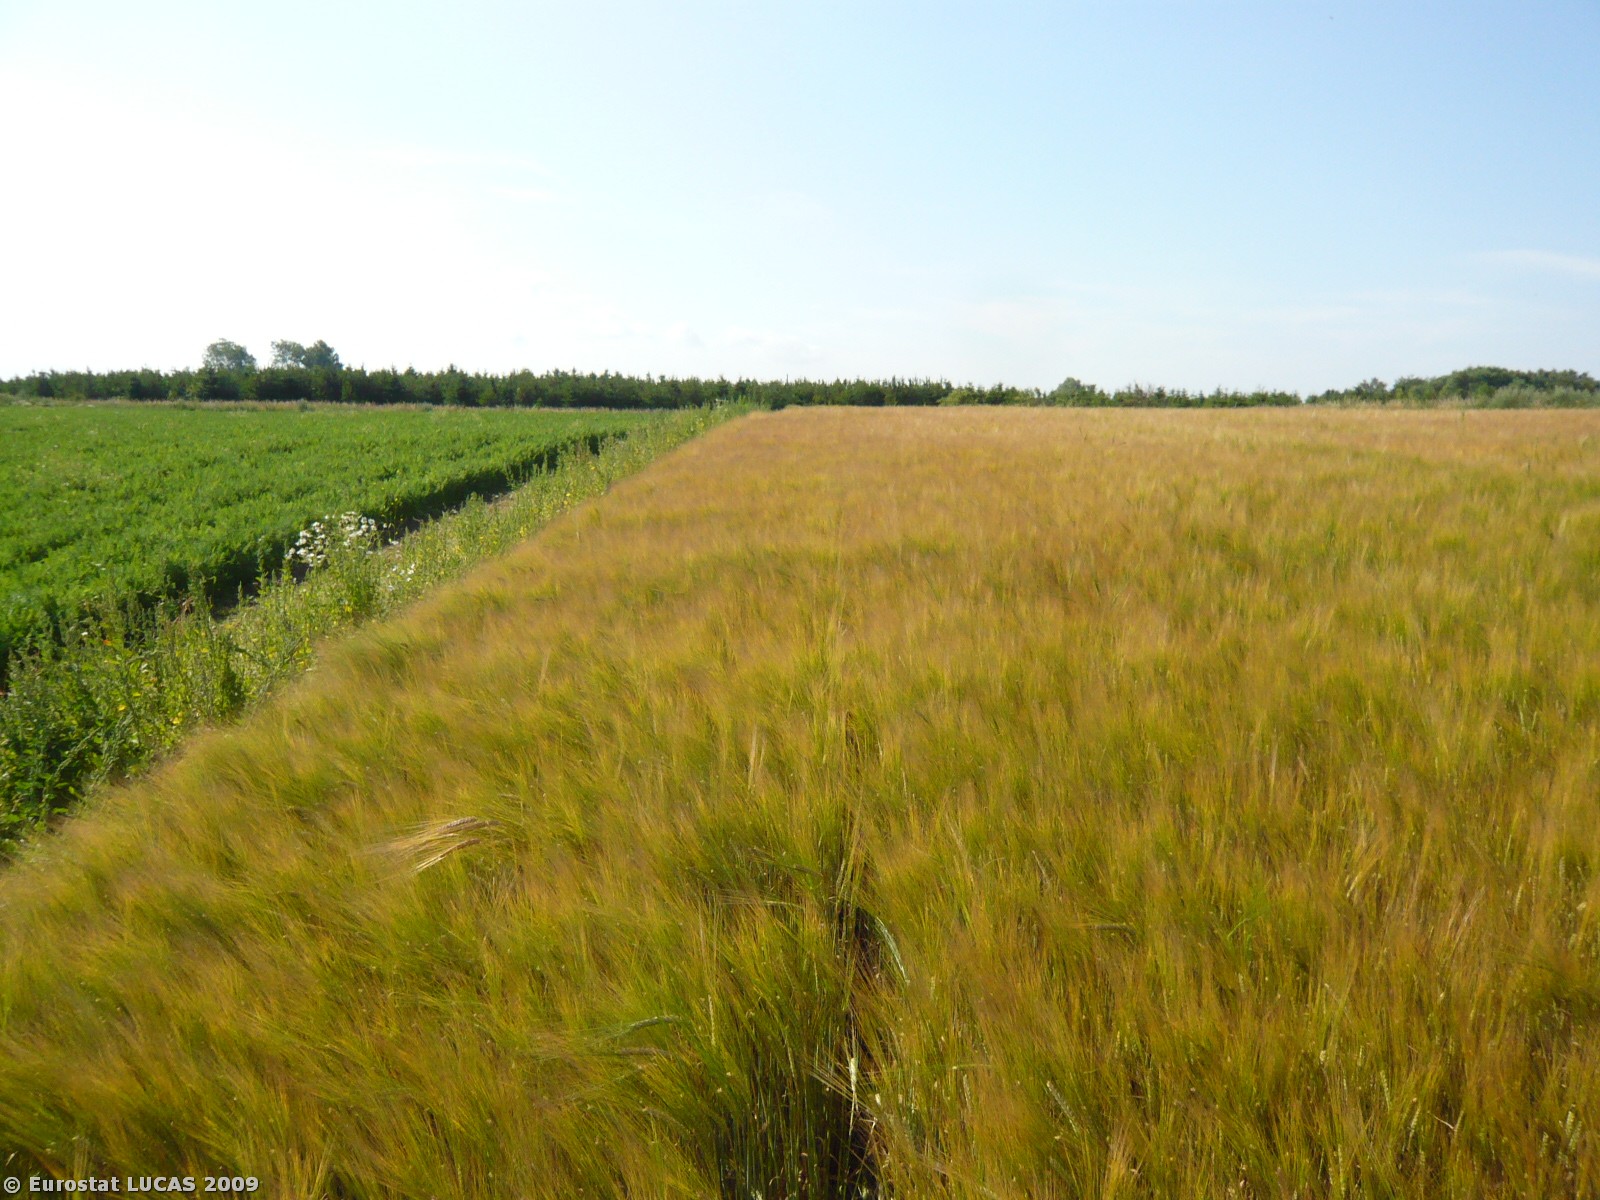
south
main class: Cropland
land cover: Barley
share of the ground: > 75 %
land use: Agriculture (excluding fallow land and kitchen gardens)
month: July
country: DK
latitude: 55.7668
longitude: 11.3853
